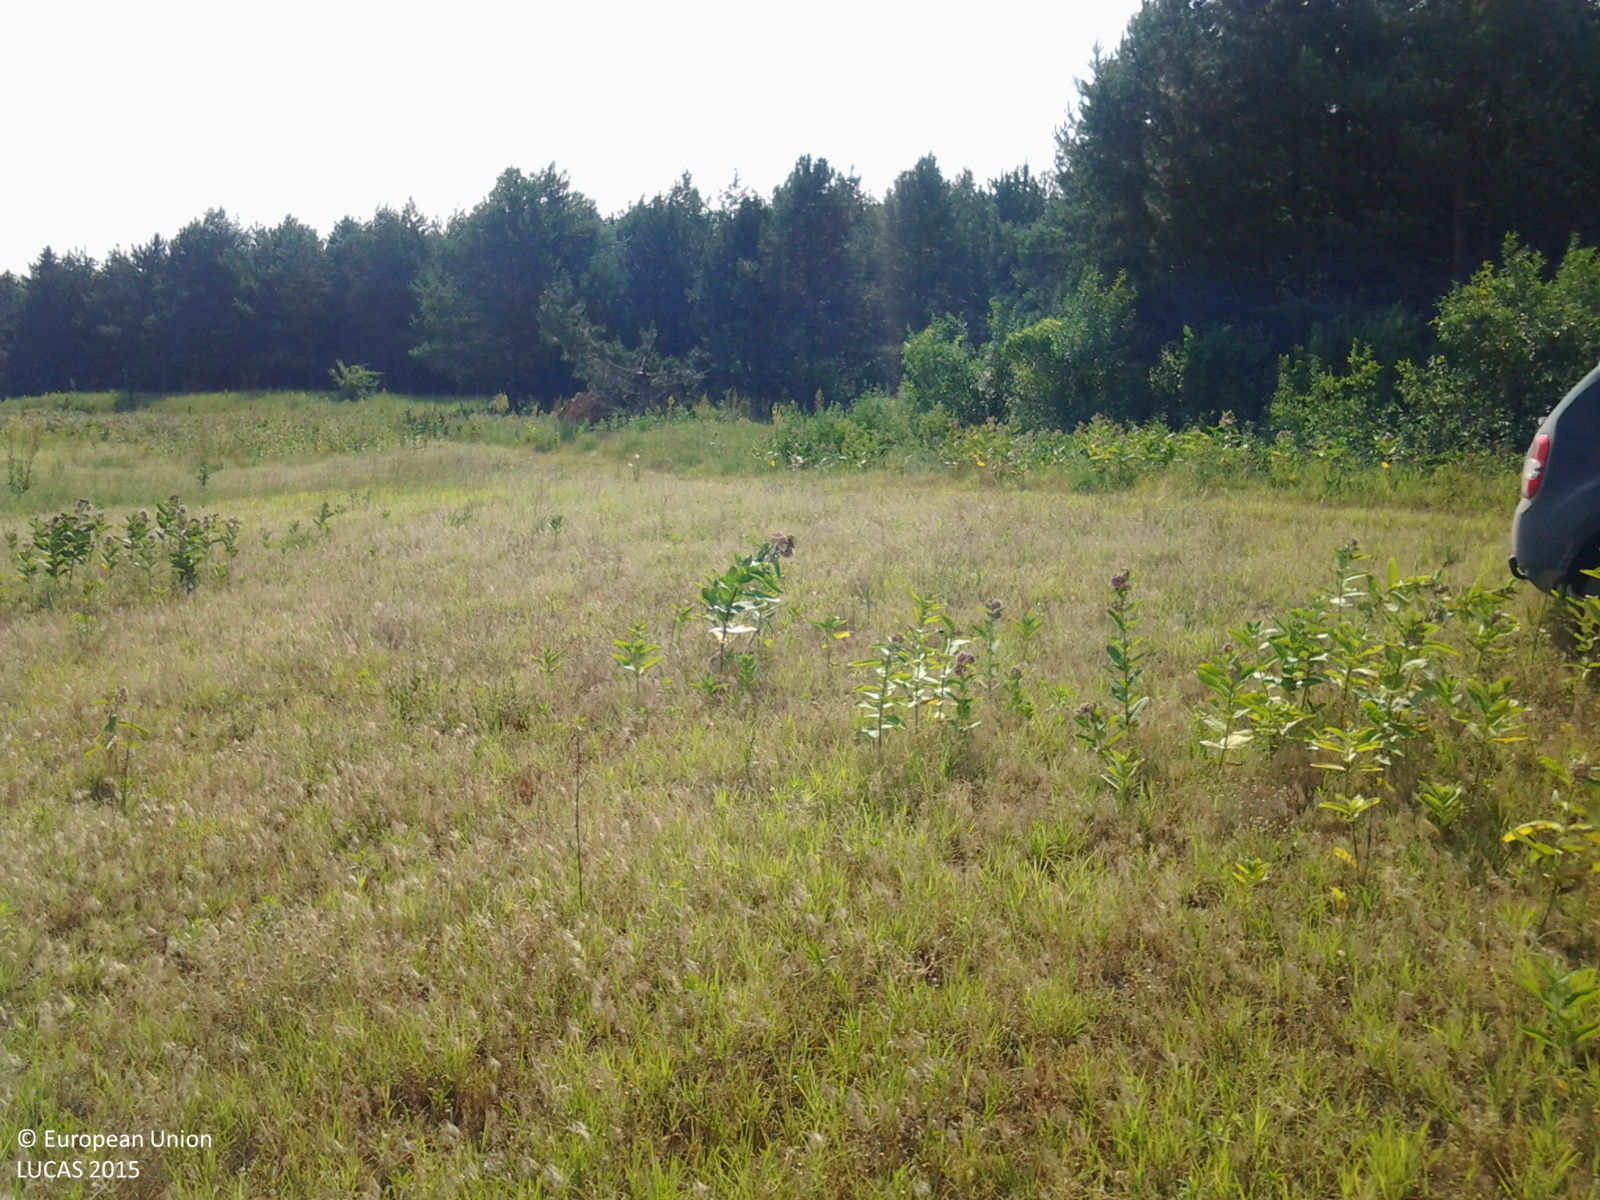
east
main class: Grassland
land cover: Spontaneously vegetated surfaces
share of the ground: > 75 %
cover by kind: herbaceous plants 100 %
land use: Fallow land
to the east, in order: Spontaneously vegetated surfaces; Tracks; Spontaneously vegetated surfaces; Spruce dominated coniferous woodland; Broadleaved woodland; Spruce dominated coniferous woodland
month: June
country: HU
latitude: 46.3748
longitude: 19.1536
